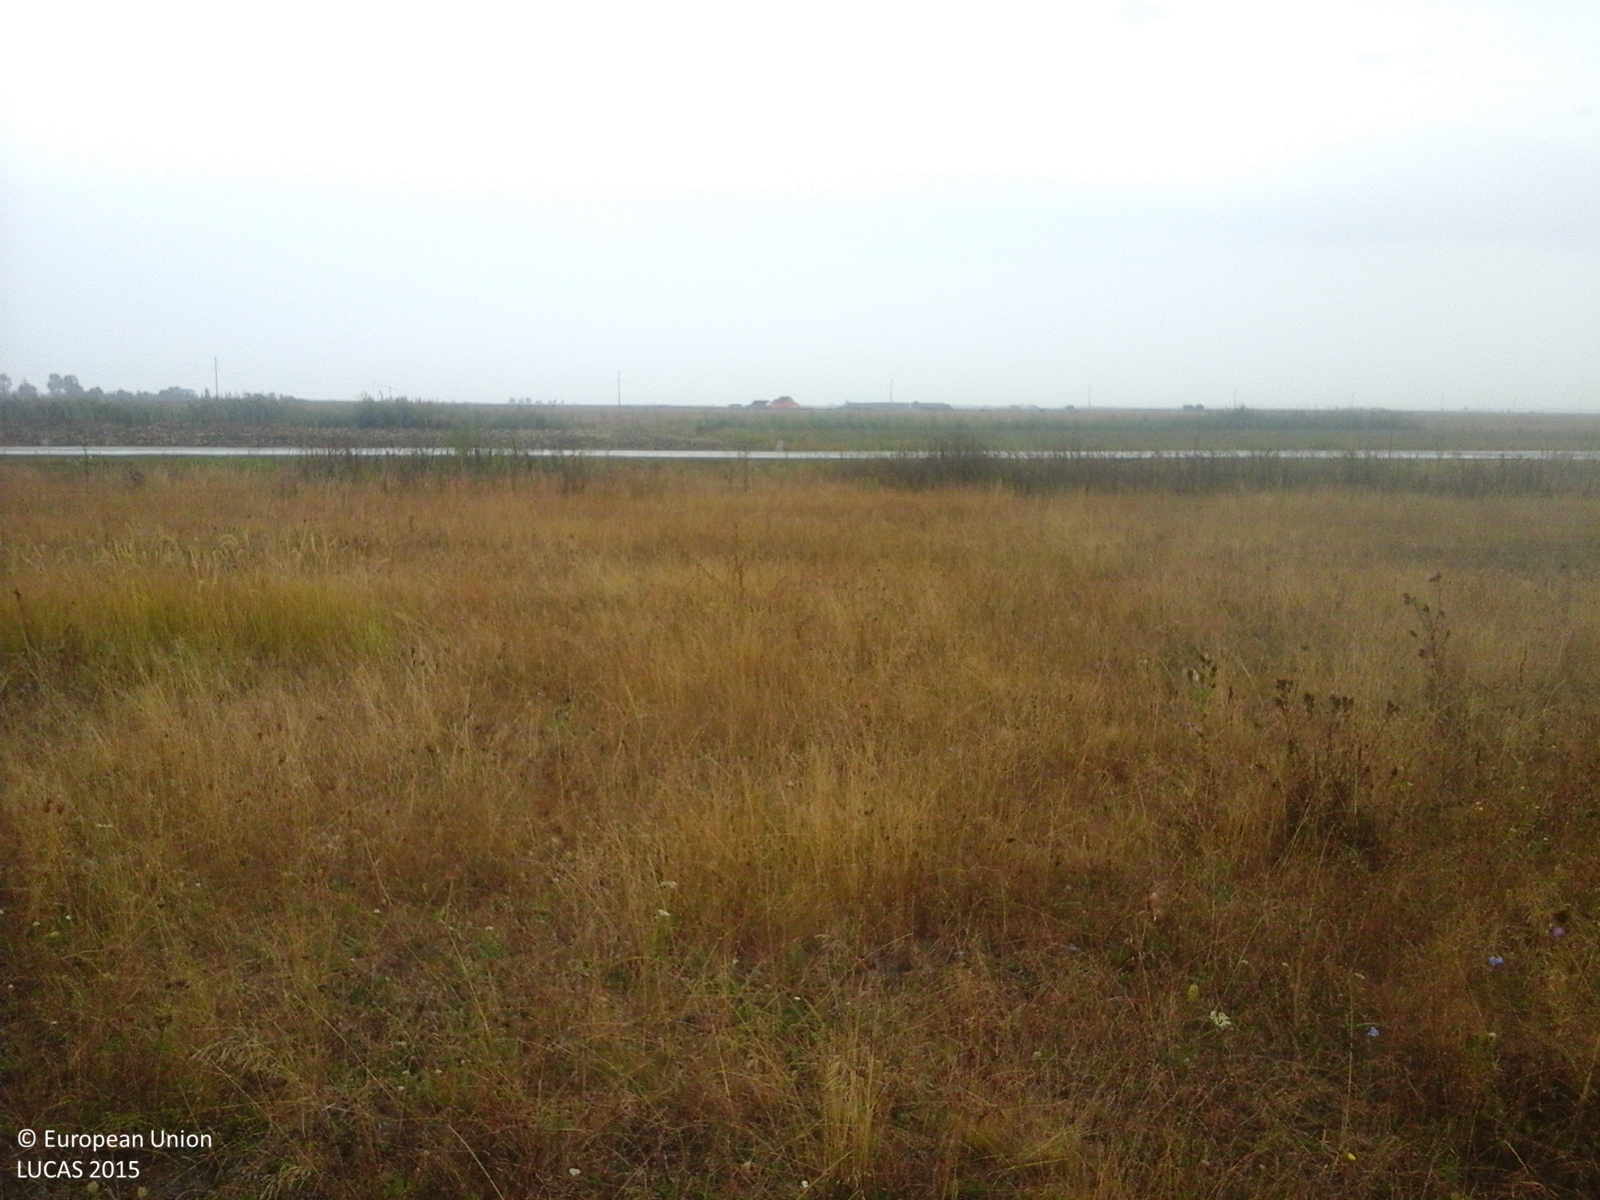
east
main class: Grassland
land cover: Grassland without tree/shrub cover
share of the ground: > 75 %
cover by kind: herbaceous plants 100 %
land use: Agriculture (excluding fallow land and kitchen gardens)
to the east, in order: Grassland without tree/shrub cover; Paved roads, cycling and walking lanes; Grass margins; Ditches and canals; Maize; Ditches and canals; Grassland without tree/shrub cover
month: September
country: RO
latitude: 47.5945
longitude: 22.5460
